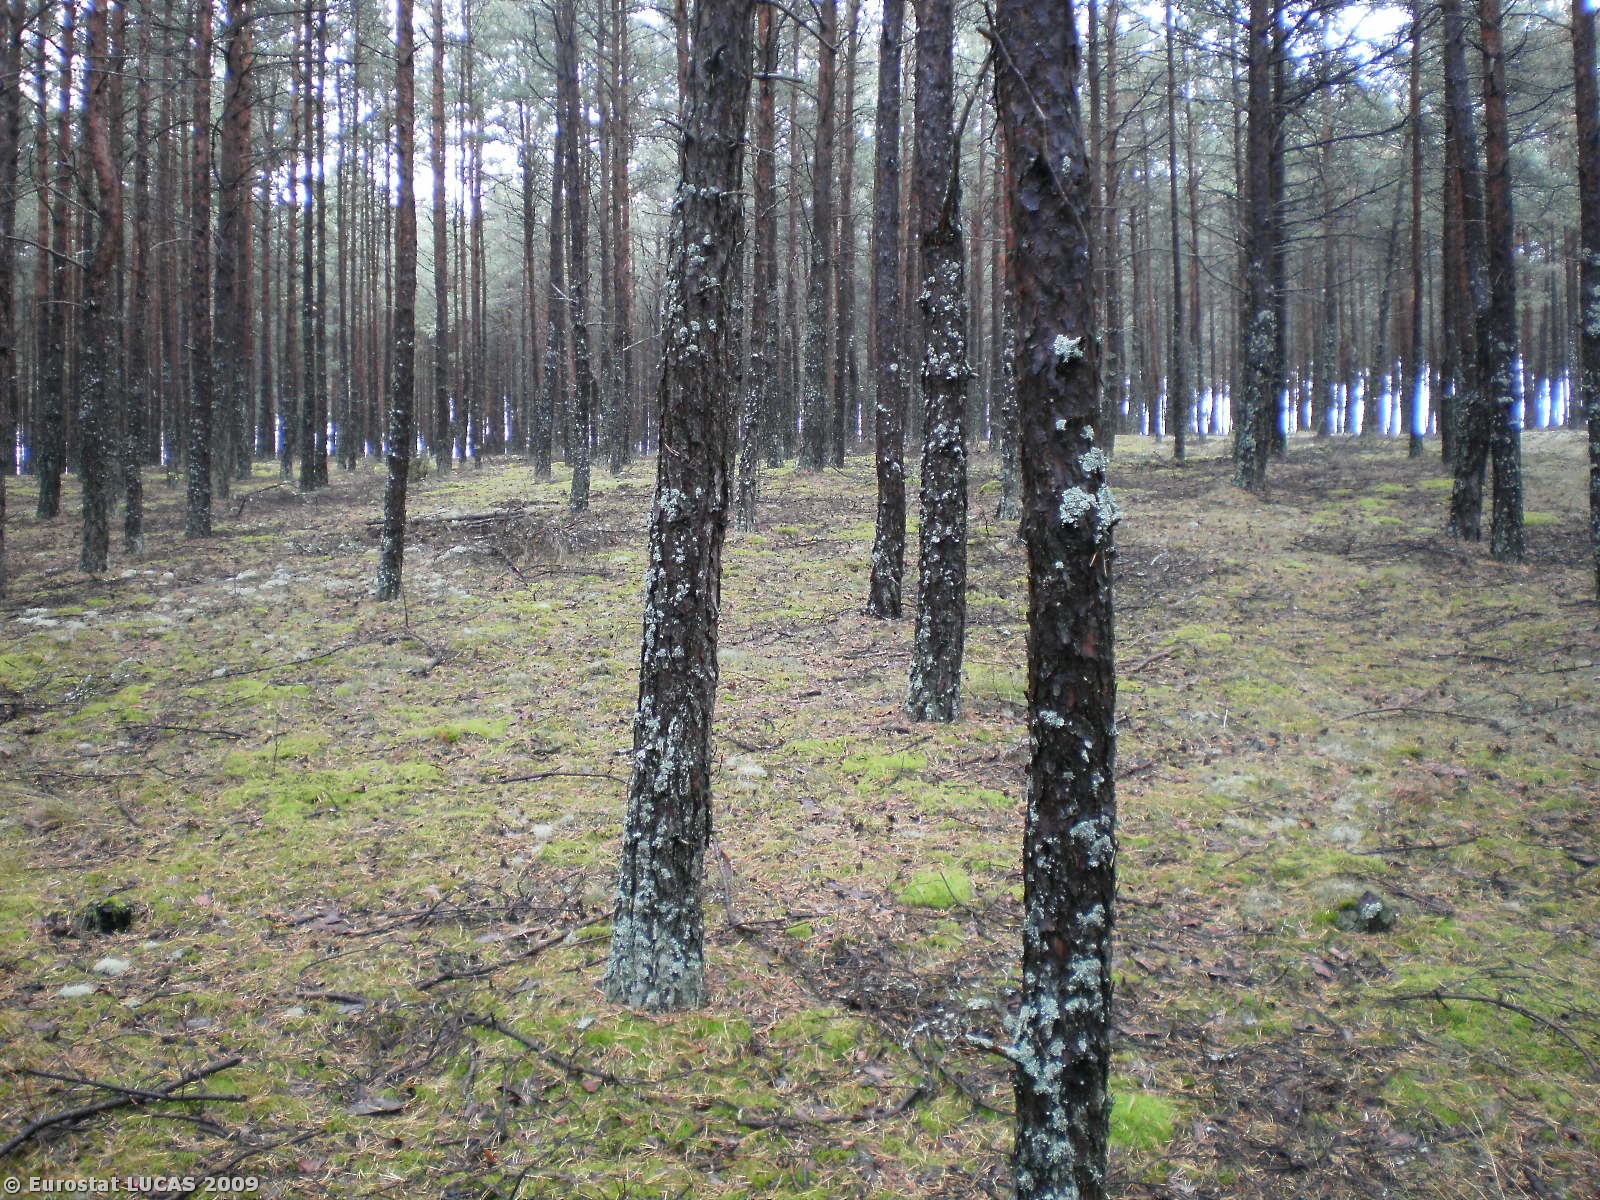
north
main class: Woodland
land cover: Coniferous woodland
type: hemiboreal forest and nemoral coniferous forest and mixed broadleaved-coniferous forest
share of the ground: > 75 %
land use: Forestry
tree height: > 5 m
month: September
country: PL
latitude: 53.8341
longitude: 17.8389
